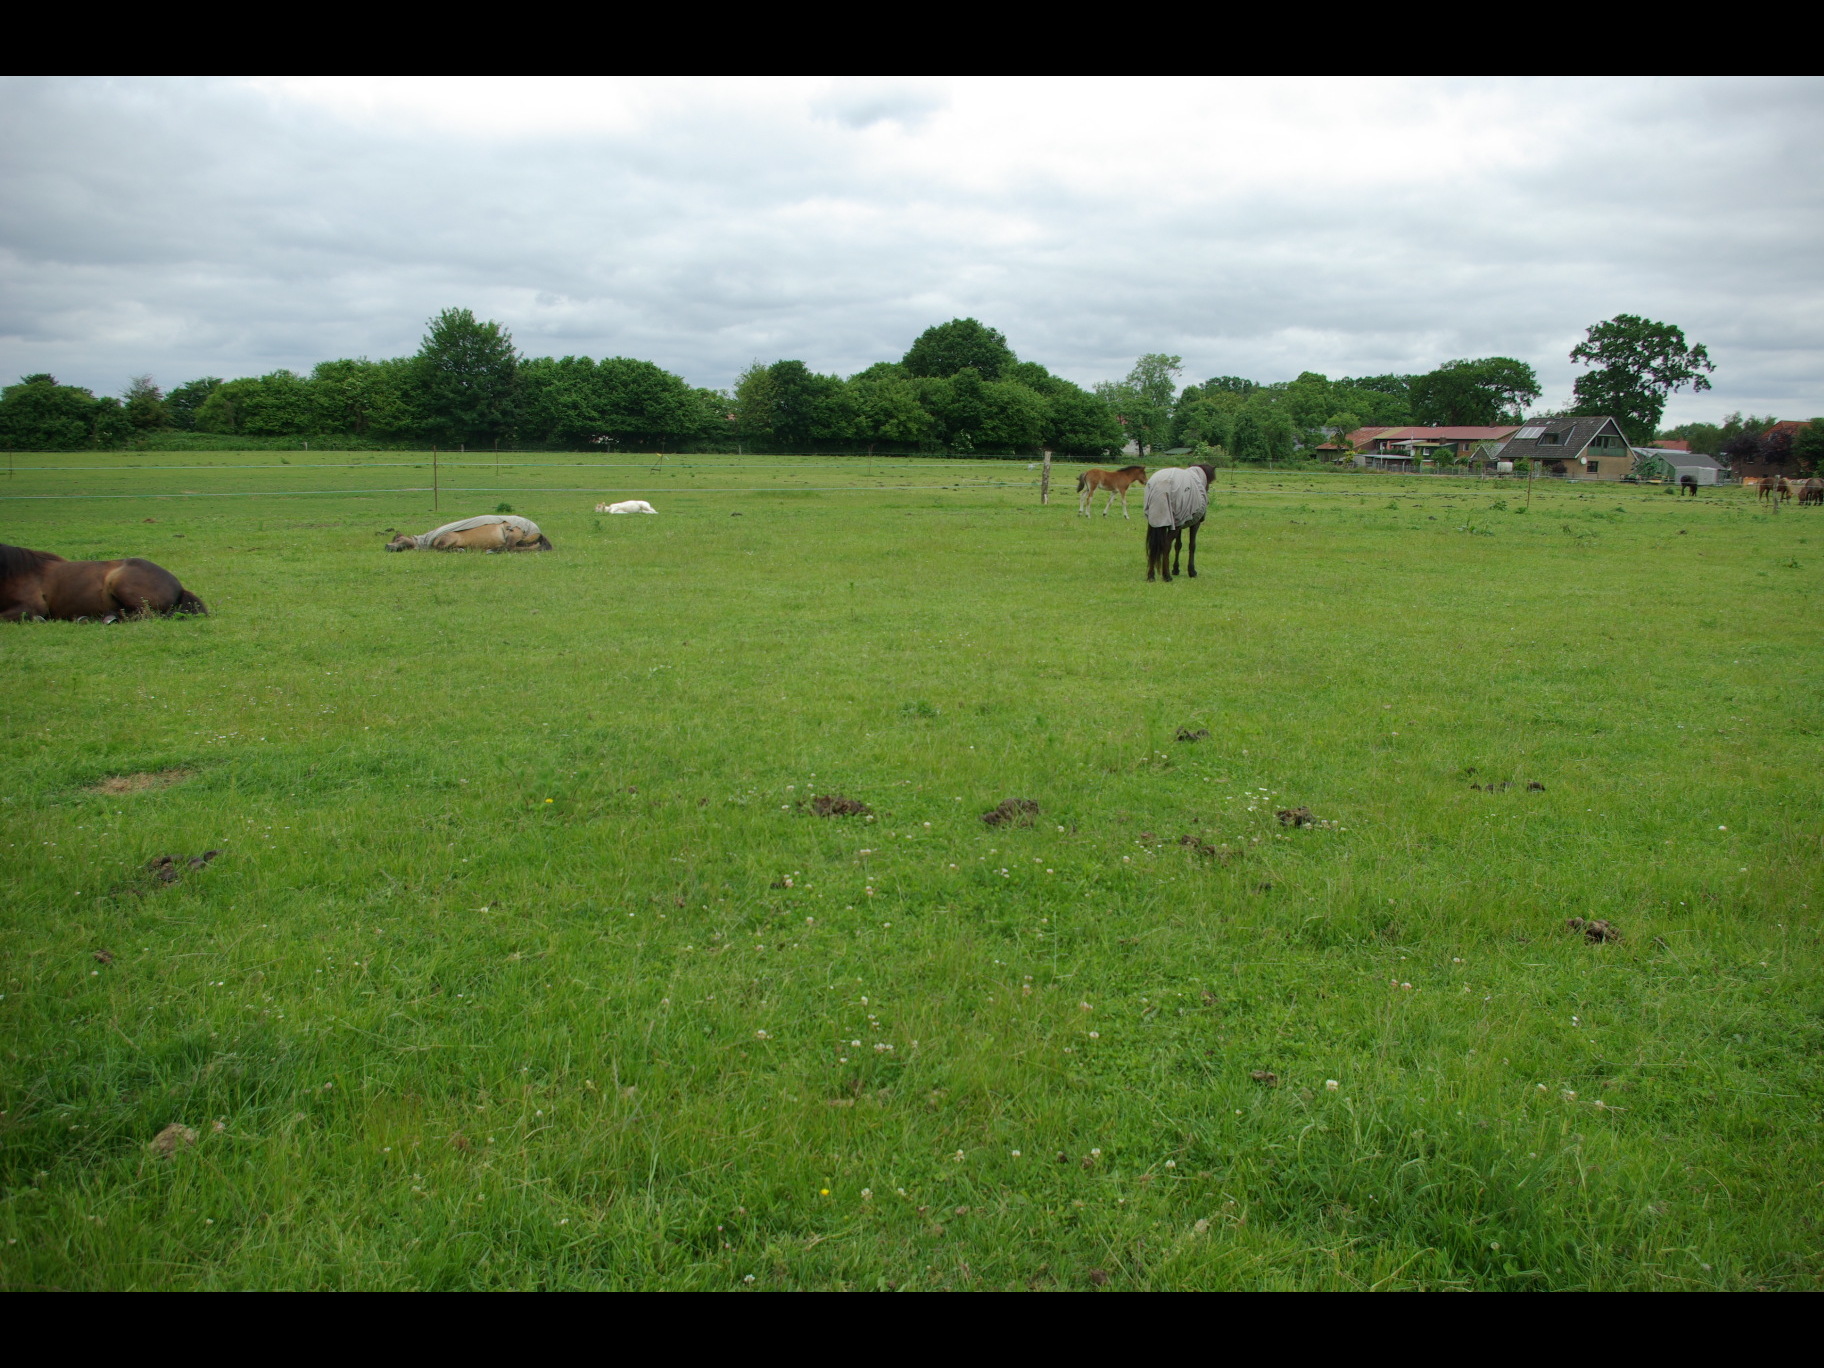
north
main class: Grassland
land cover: Grassland without tree/shrub cover
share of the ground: > 75 %
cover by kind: herbaceous plants 100 %
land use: Agriculture (excluding fallow land and kitchen gardens)
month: June
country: DE
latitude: 54.0489
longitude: 9.8931
